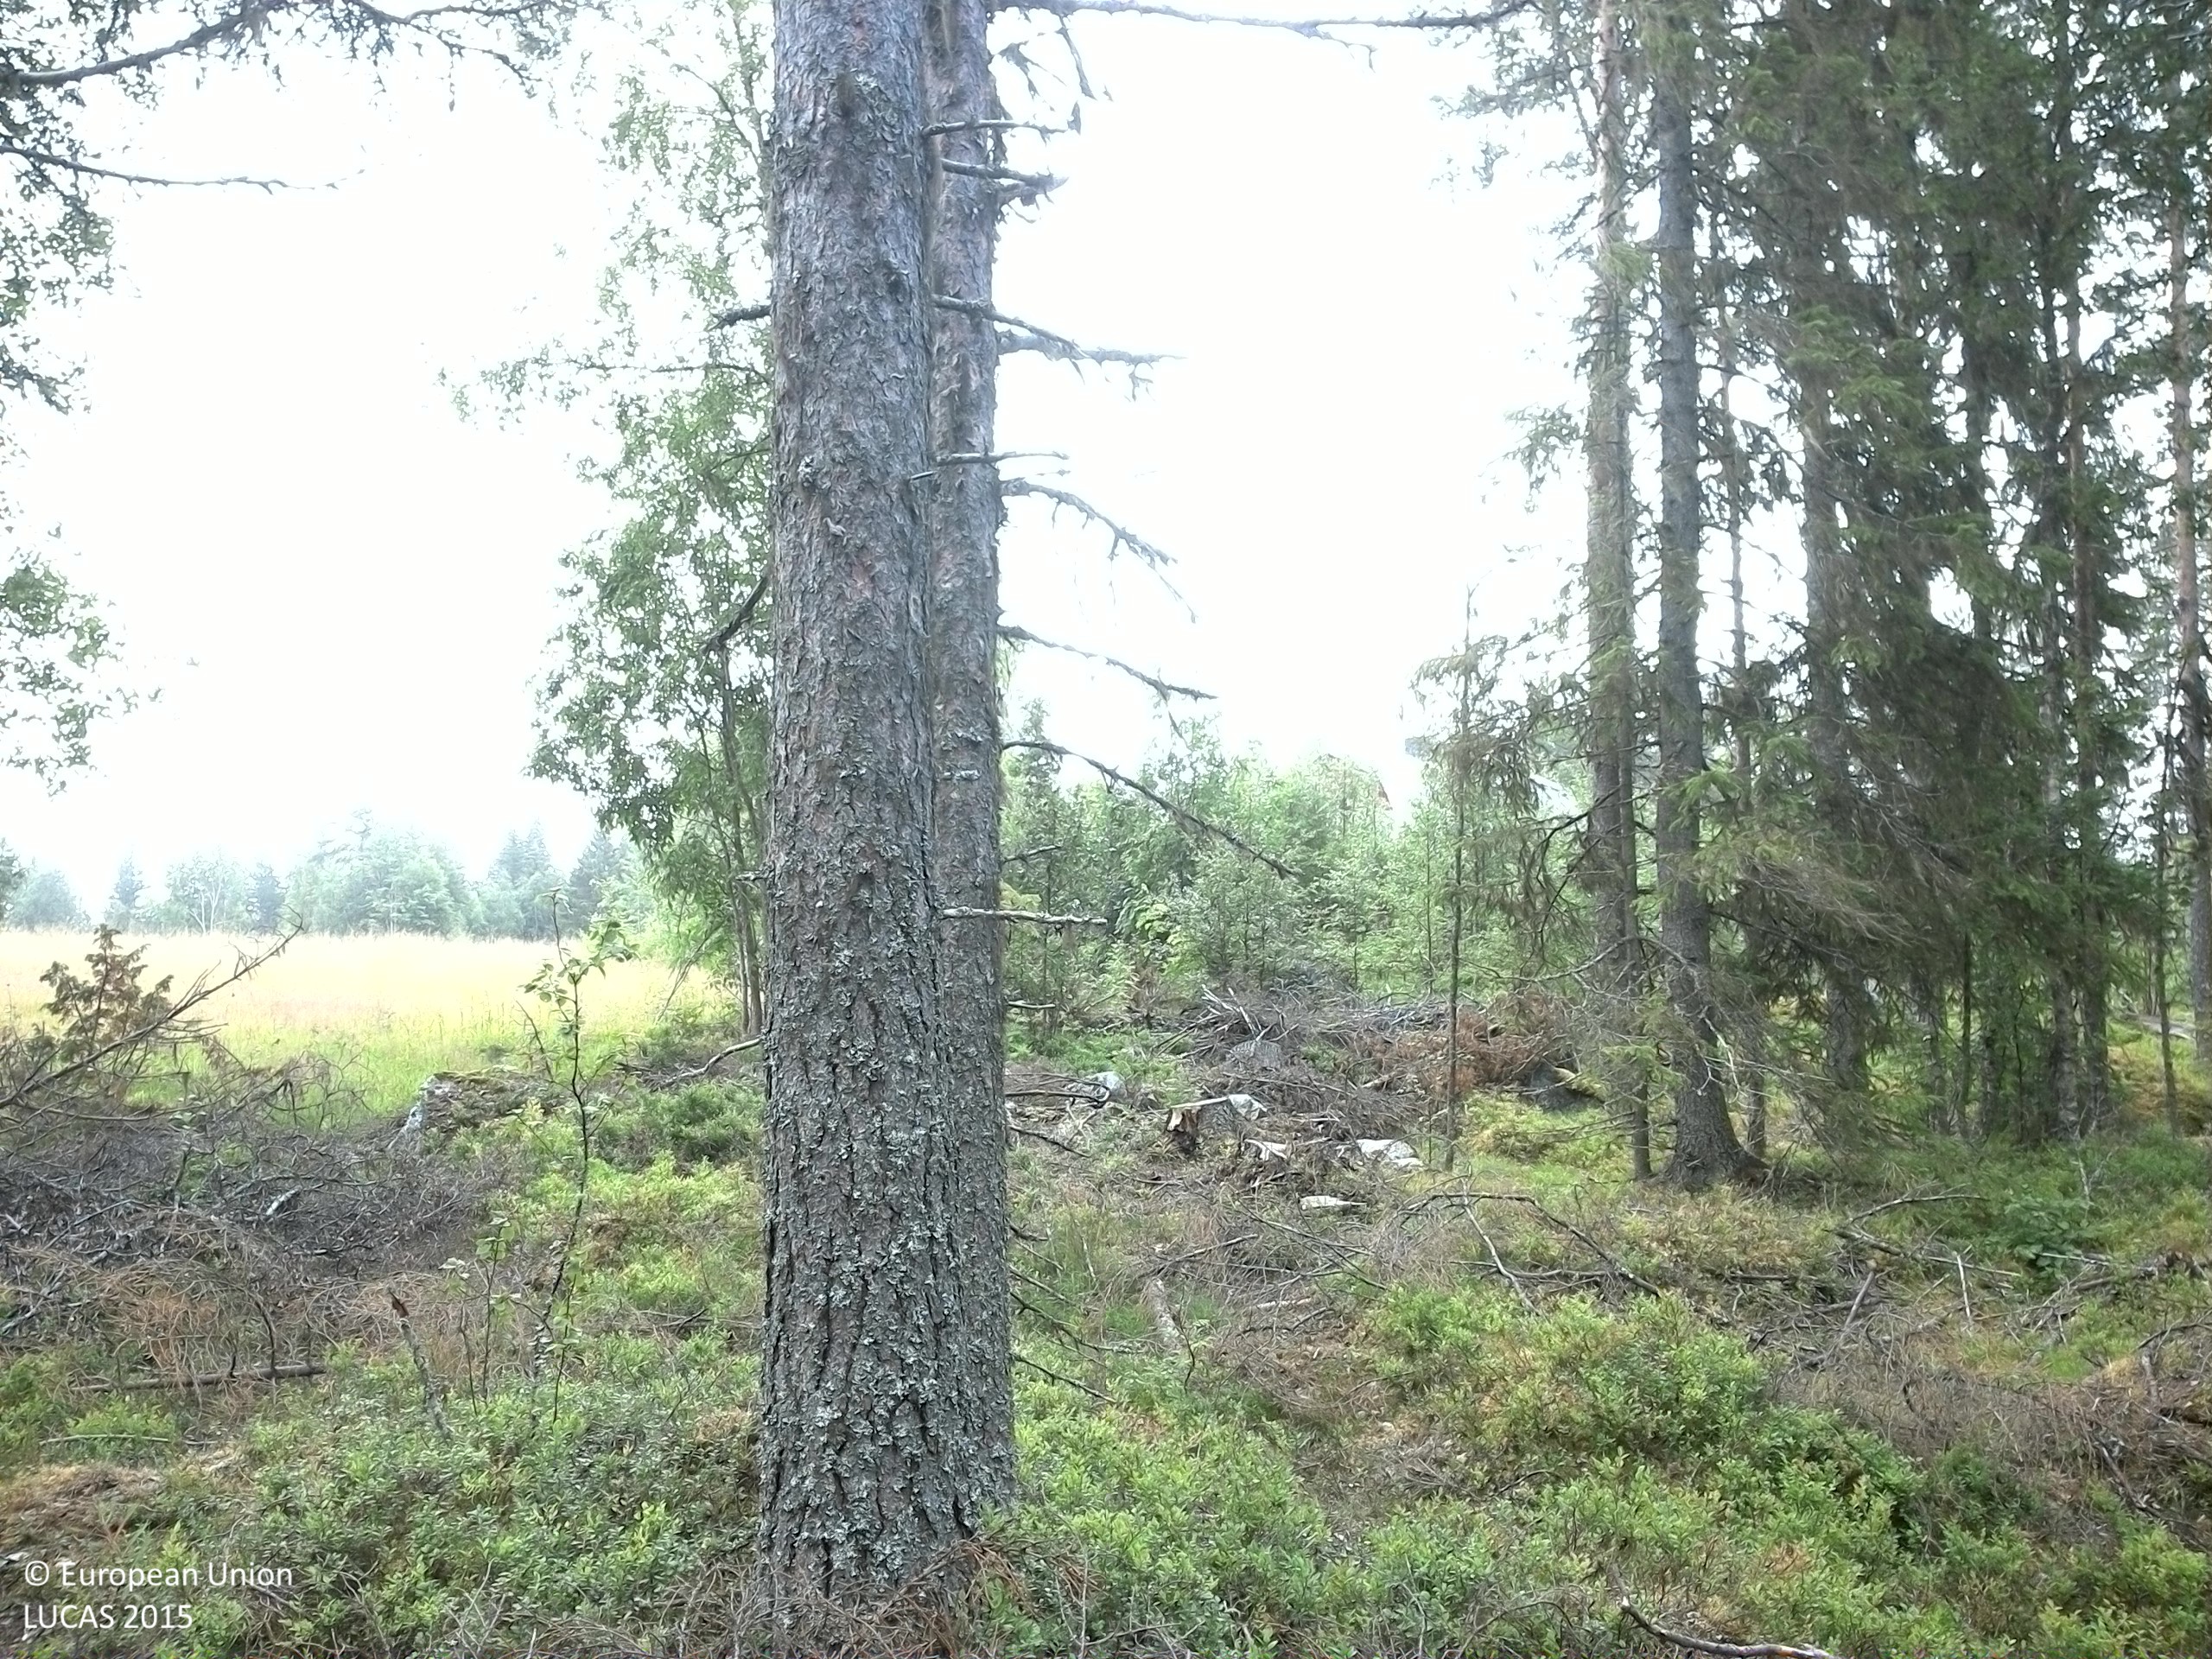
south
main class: Woodland
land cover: Spruce dominated coniferous woodland
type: boreal forest
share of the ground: 50 - 75 %
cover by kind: coniferous forest trees 60 %, broadleaved forest trees 15 %, shrubs 10 %, lichens and mosses 5 %
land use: Forestry
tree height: > 5 m
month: August
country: SE
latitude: 63.9087
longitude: 17.9401
